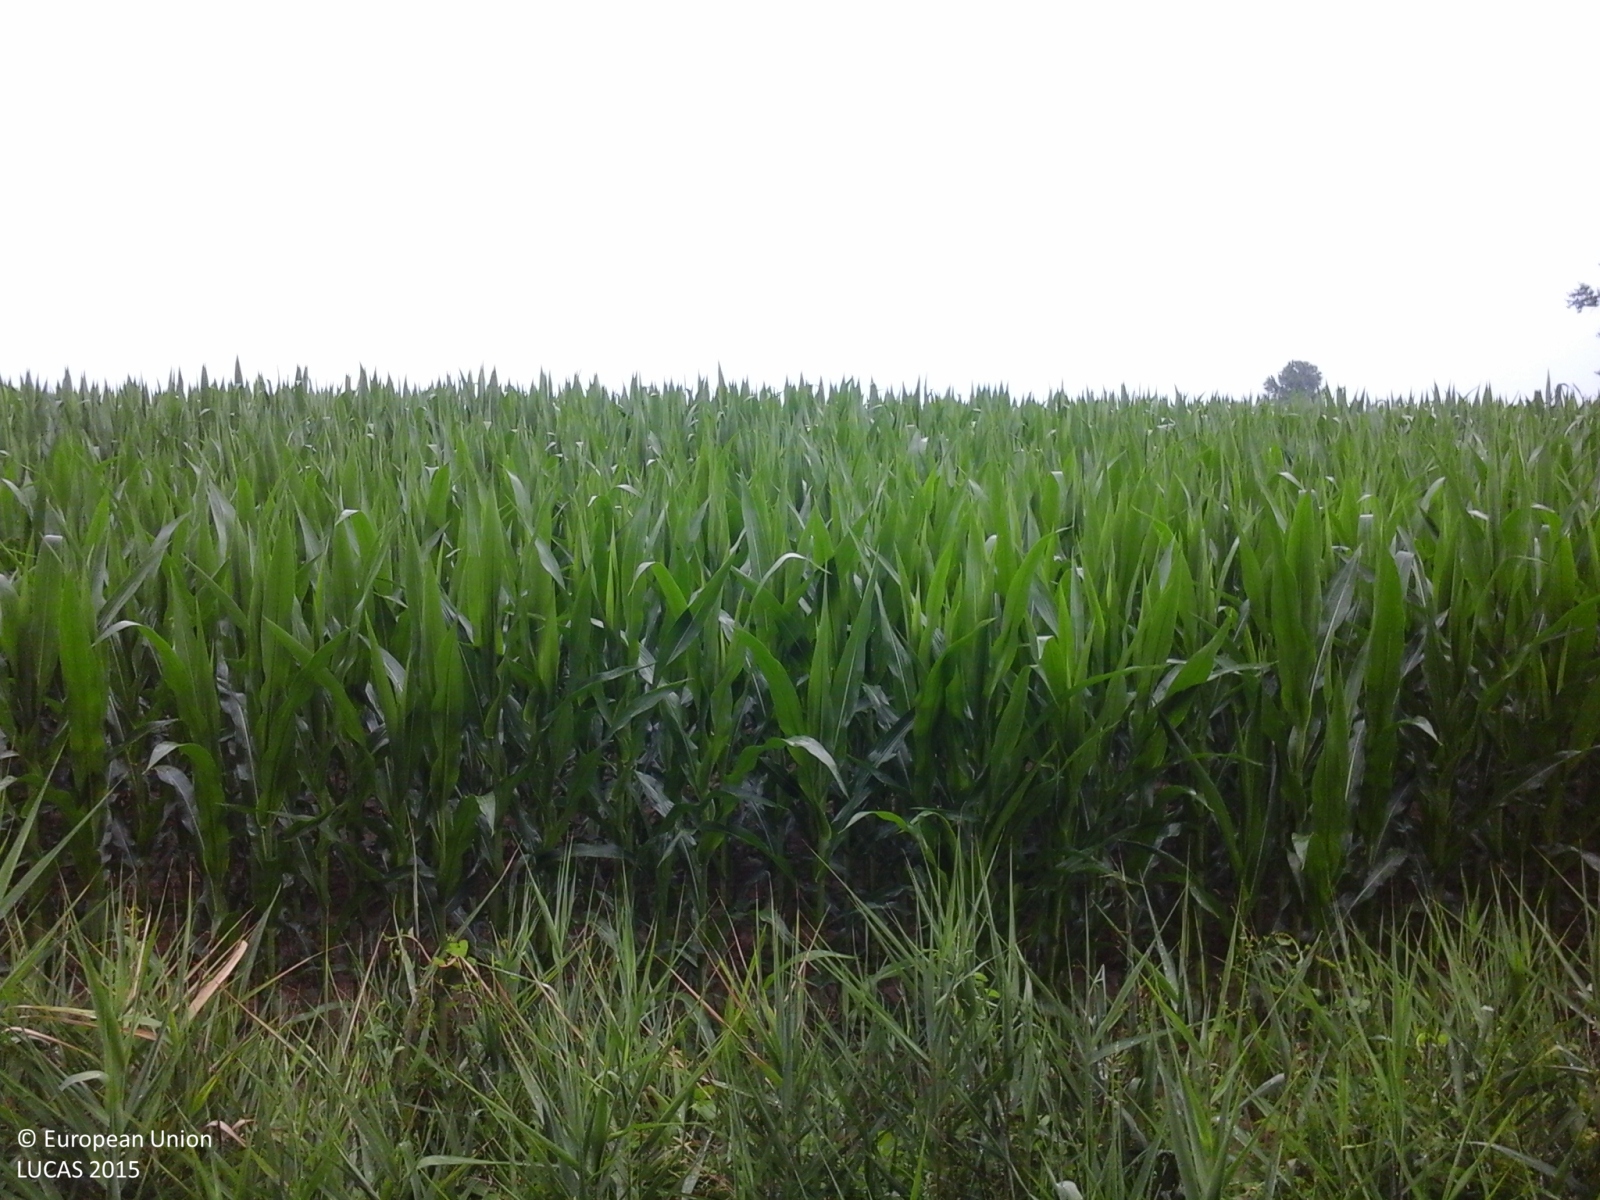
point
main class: Cropland
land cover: Maize
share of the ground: > 75 %
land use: Agriculture (excluding fallow land and kitchen gardens)
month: June
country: IT
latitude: 45.8190
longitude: 12.4292
